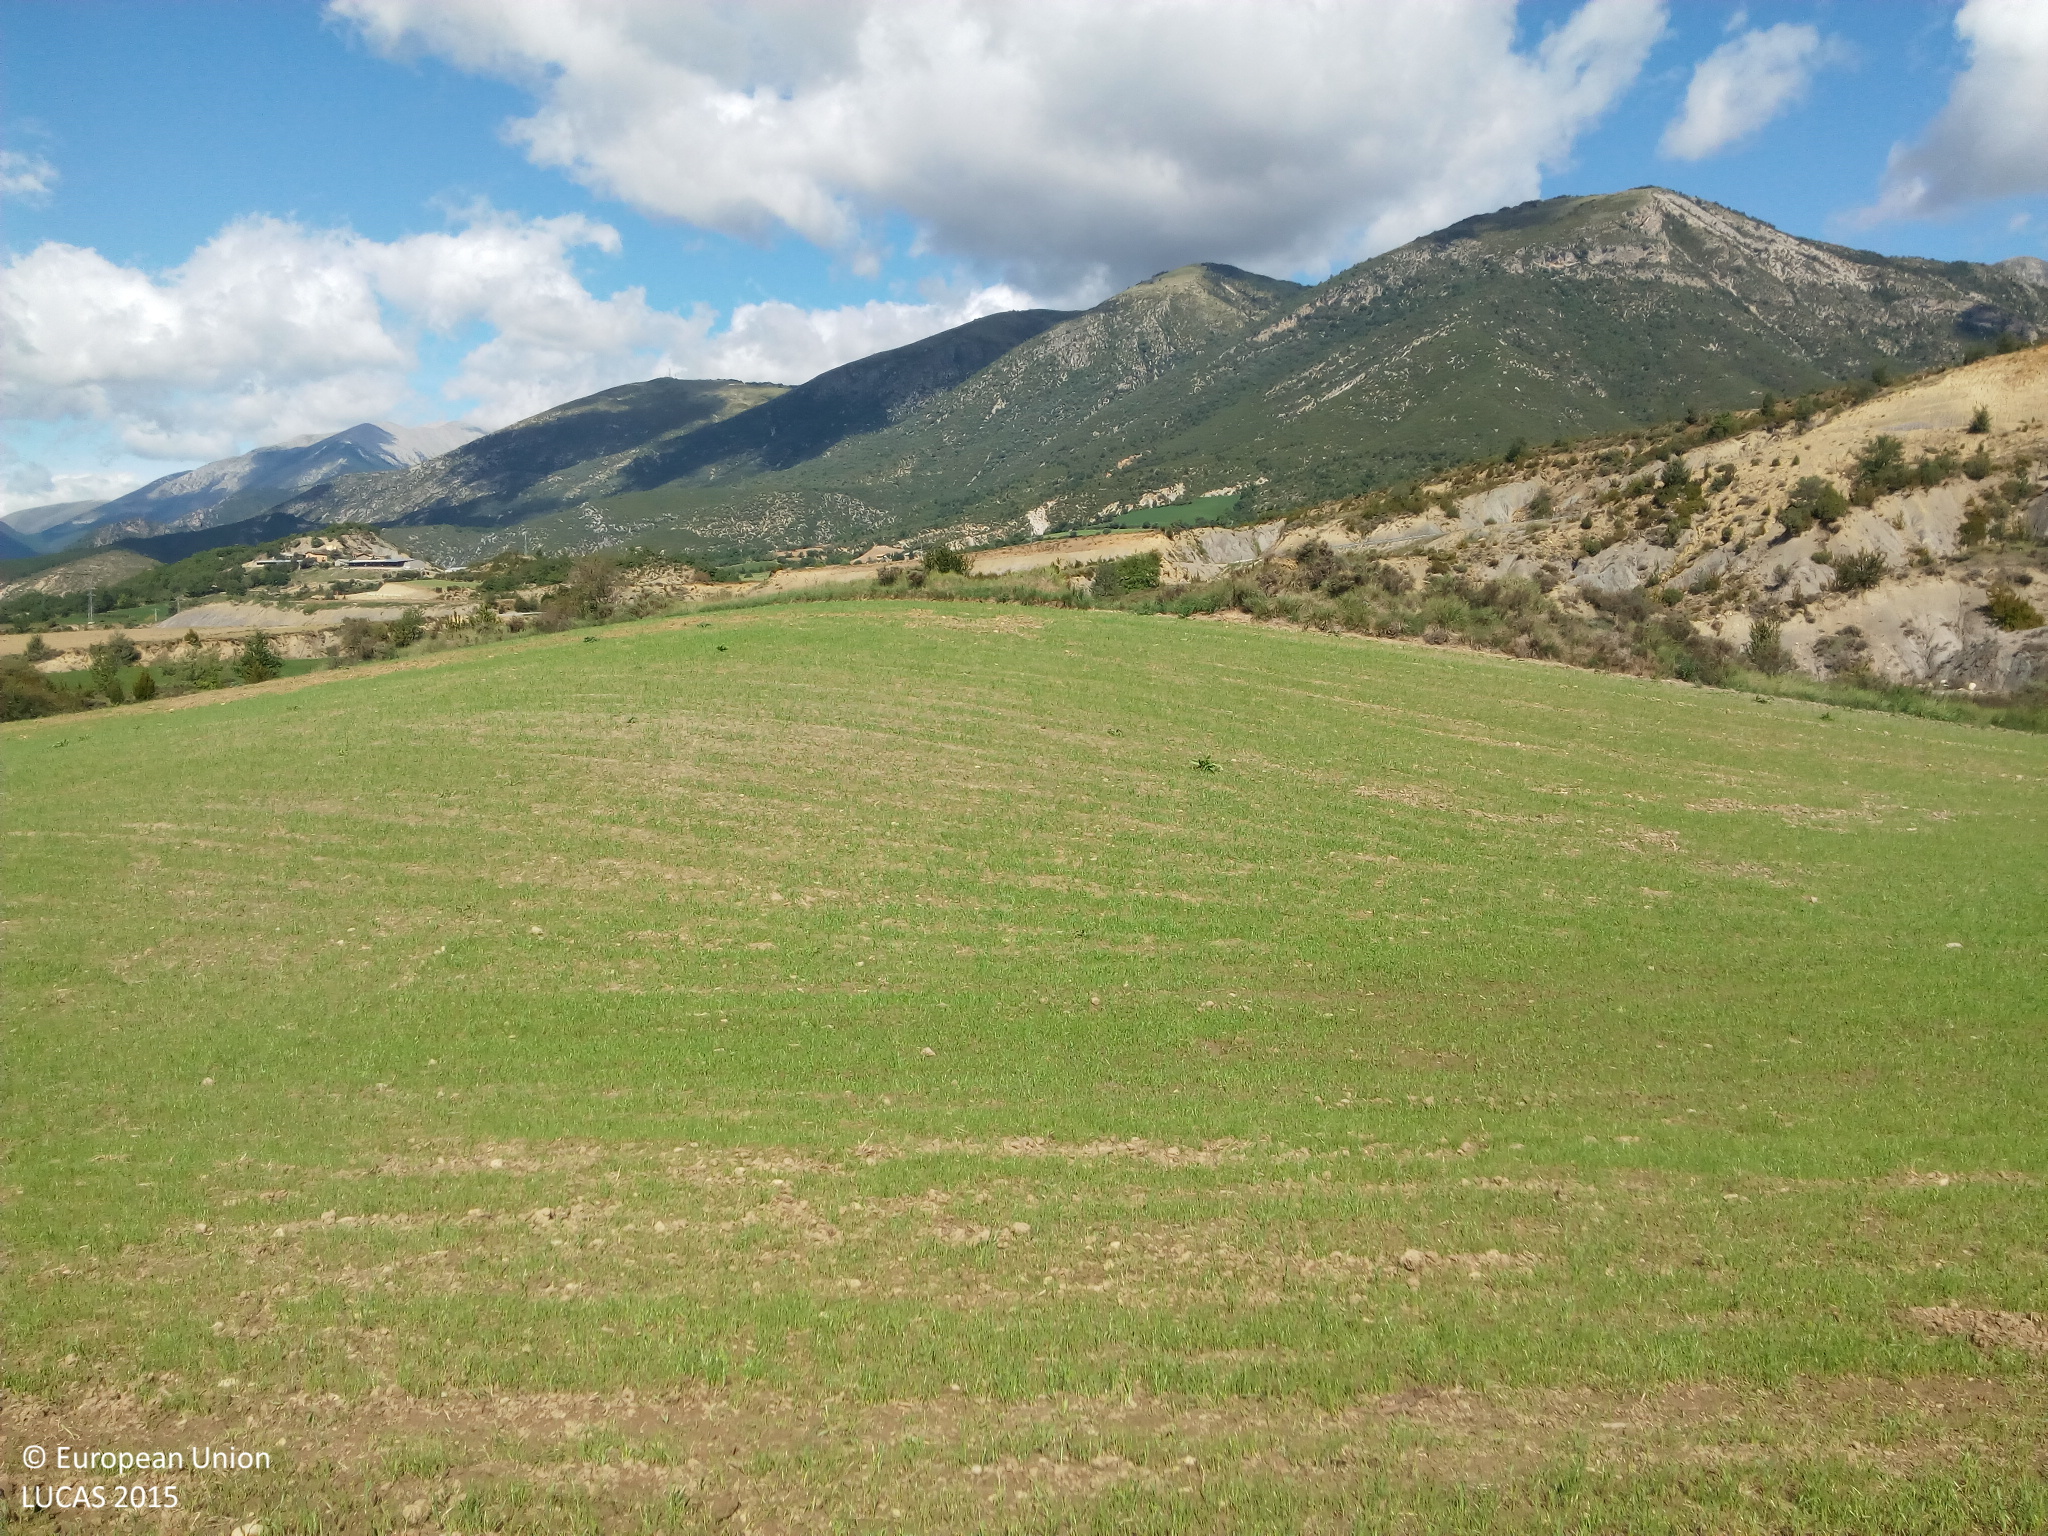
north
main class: Grassland
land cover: Spontaneously vegetated surfaces
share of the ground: > 75 %
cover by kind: herbaceous plants 75 %, unconsolidated bare surface 25 %
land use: Fallow land
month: September
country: ES
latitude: 42.4011
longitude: 0.4435
